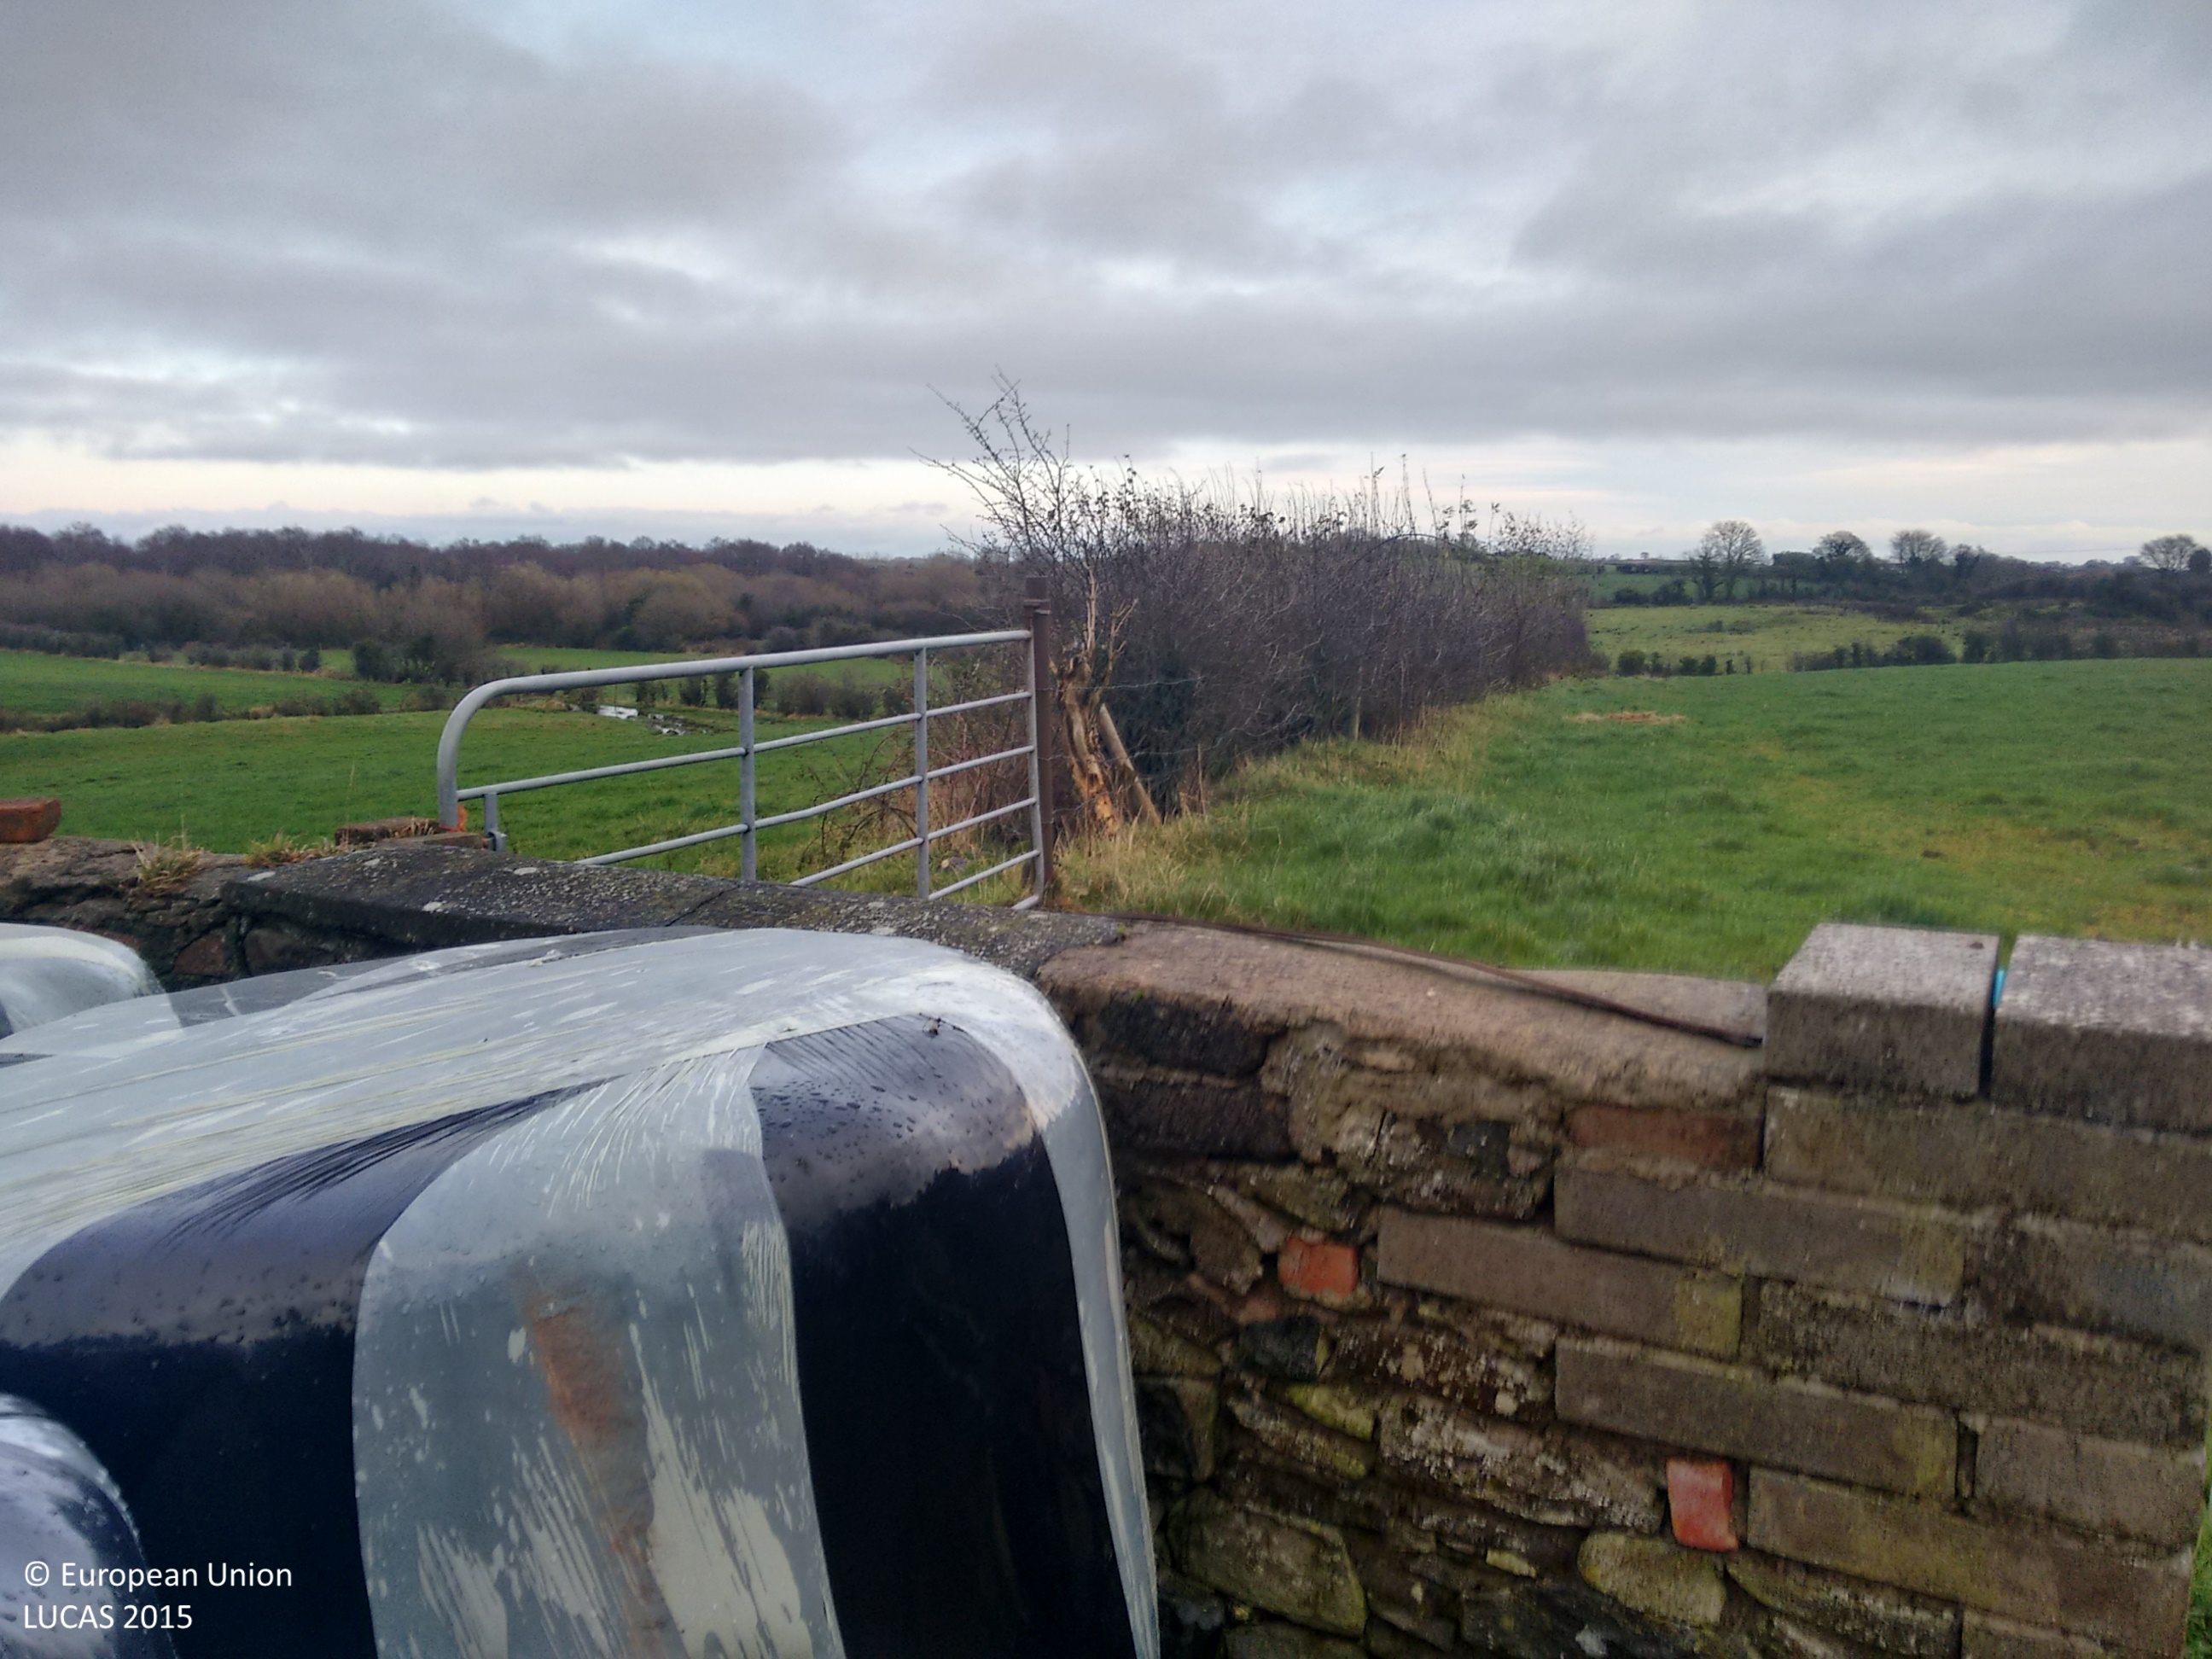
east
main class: Grassland
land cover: Grassland without tree/shrub cover
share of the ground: > 75 %
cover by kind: herbaceous plants 100 %
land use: Agriculture (excluding fallow land and kitchen gardens)
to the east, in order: Grassland without tree/shrub cover; Fences; Ditches and canals; Broadleaved woodland; Electric lines; Broadleaved woodland; Grassland without tree/shrub cover
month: November
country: GB
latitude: 54.4872
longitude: -5.7718
